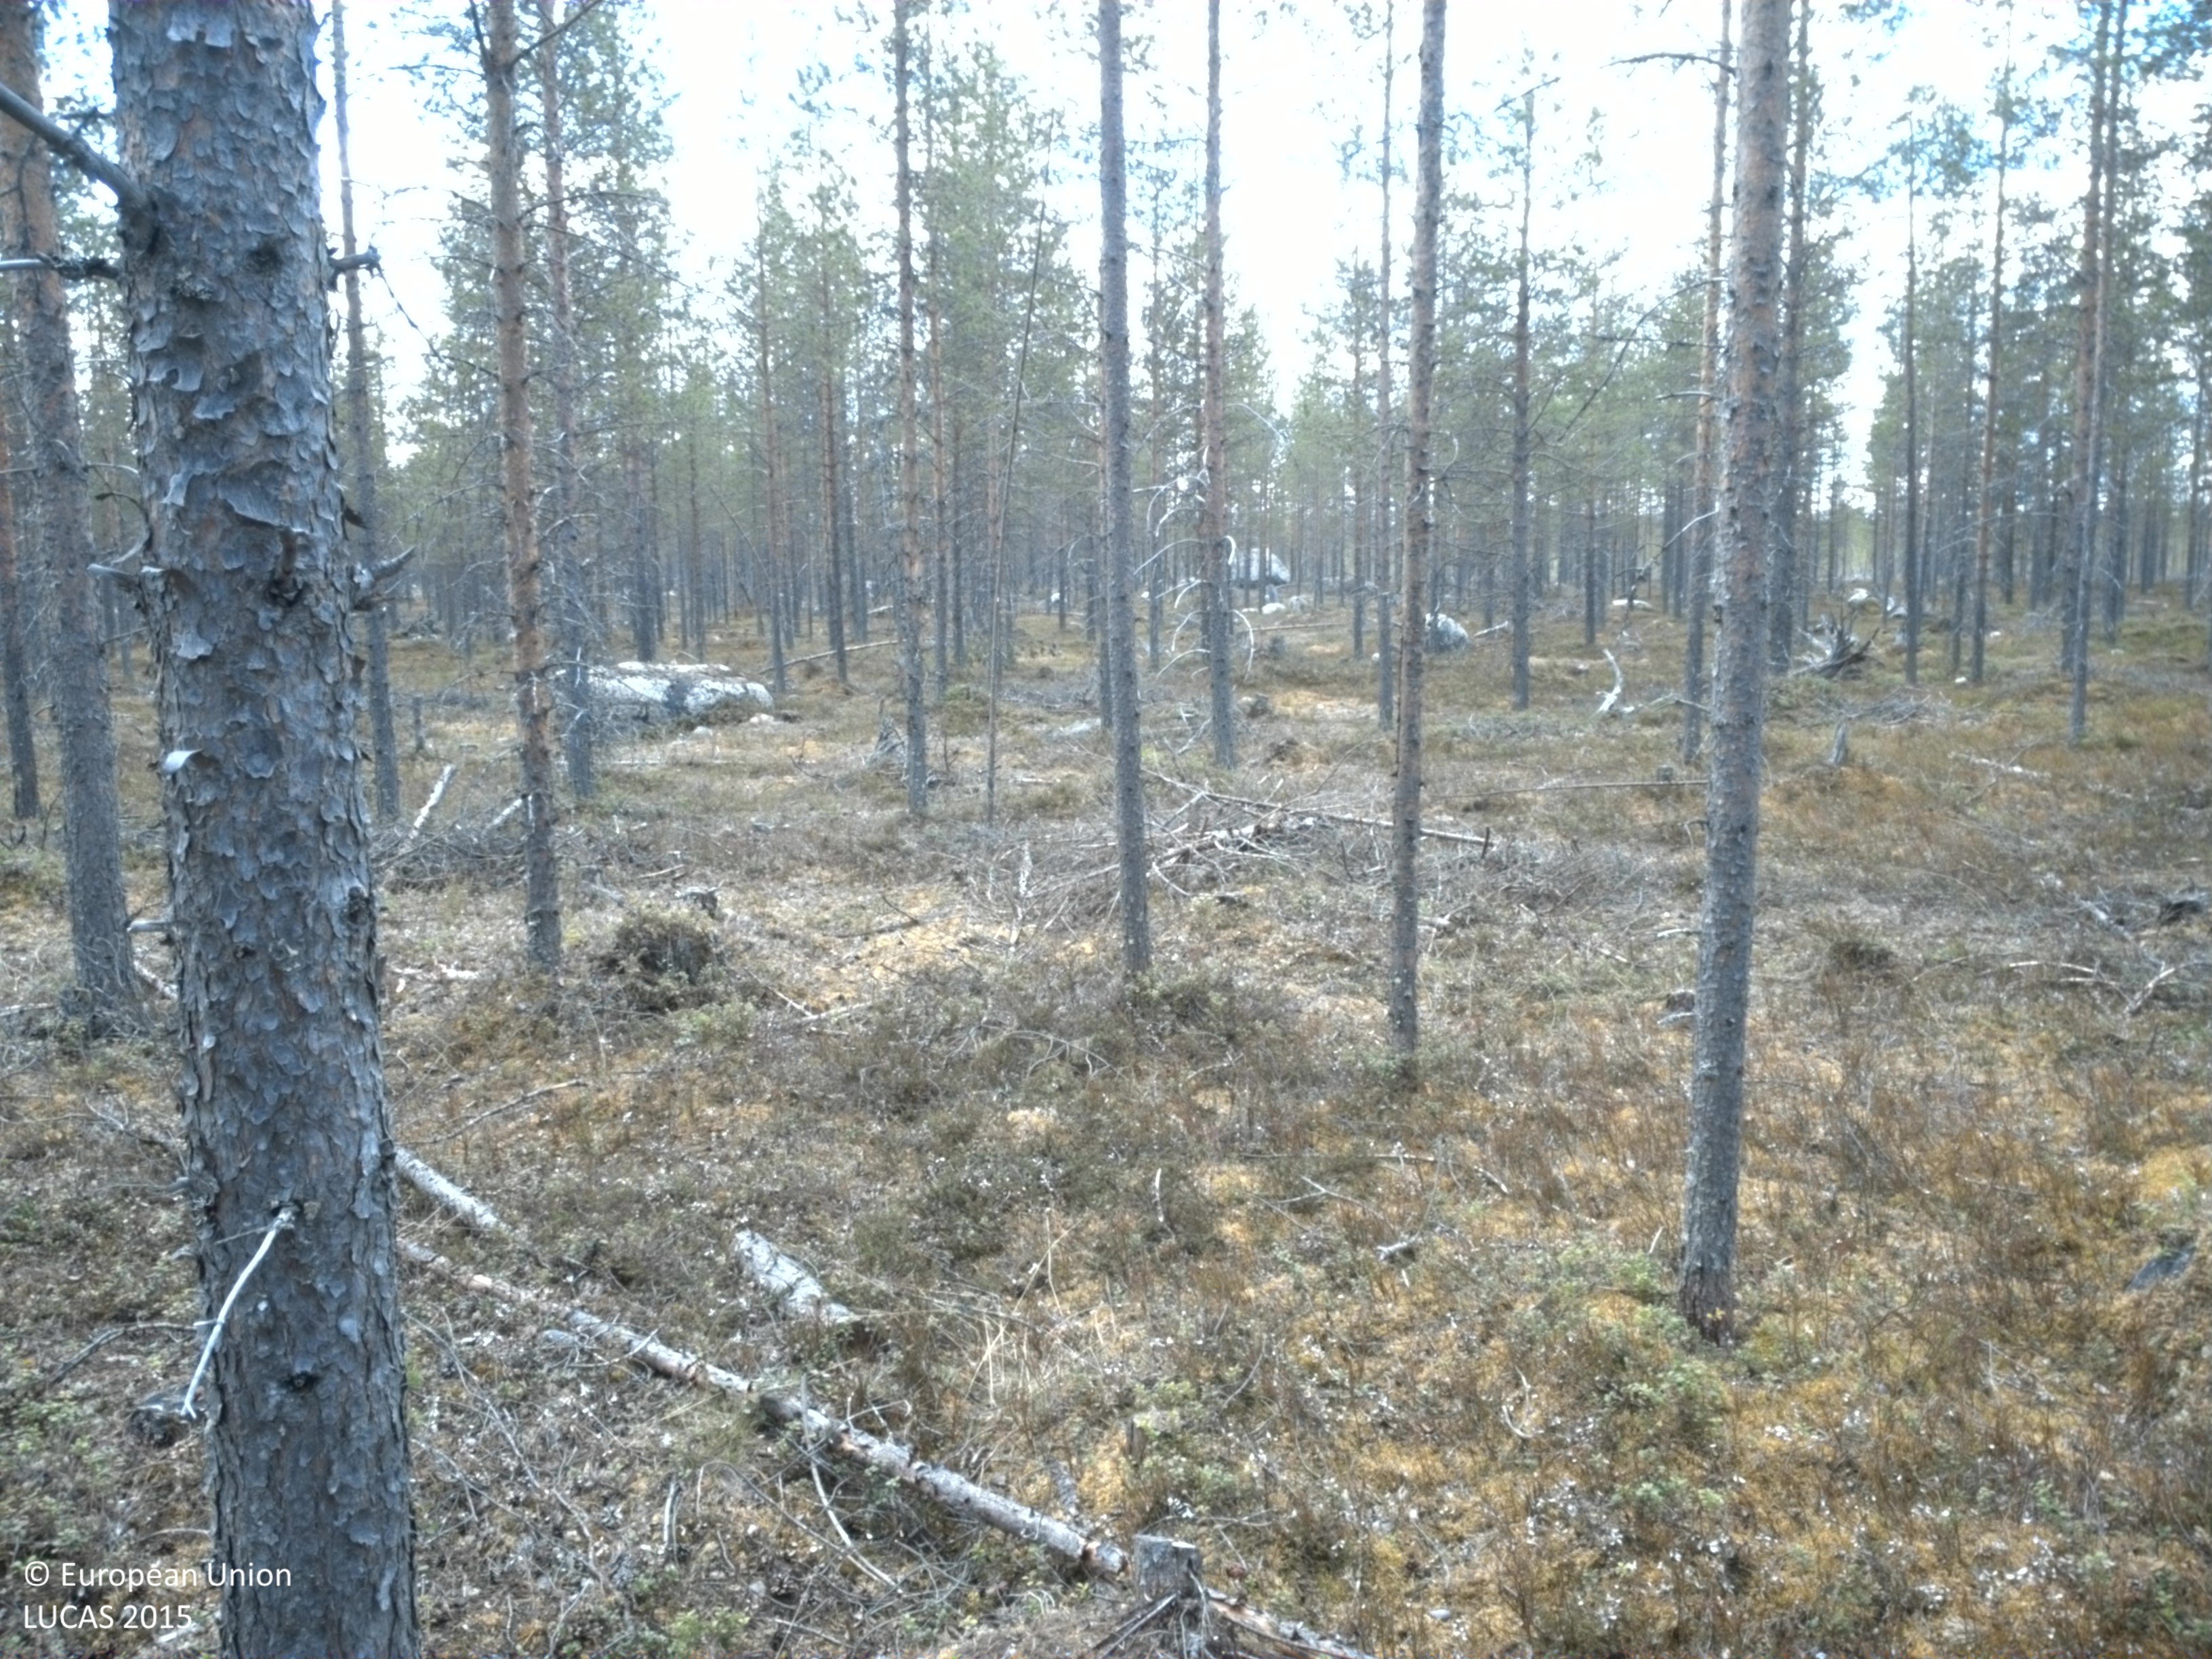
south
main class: Woodland
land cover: Pine dominated coniferous woodland
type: boreal forest
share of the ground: 25 - 50 %
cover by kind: shrubs 55 %, coniferous forest trees 40 %, lichens and mosses 5 %
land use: Forestry
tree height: > 5 m
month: June
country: SE
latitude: 66.2391
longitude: 18.6056
